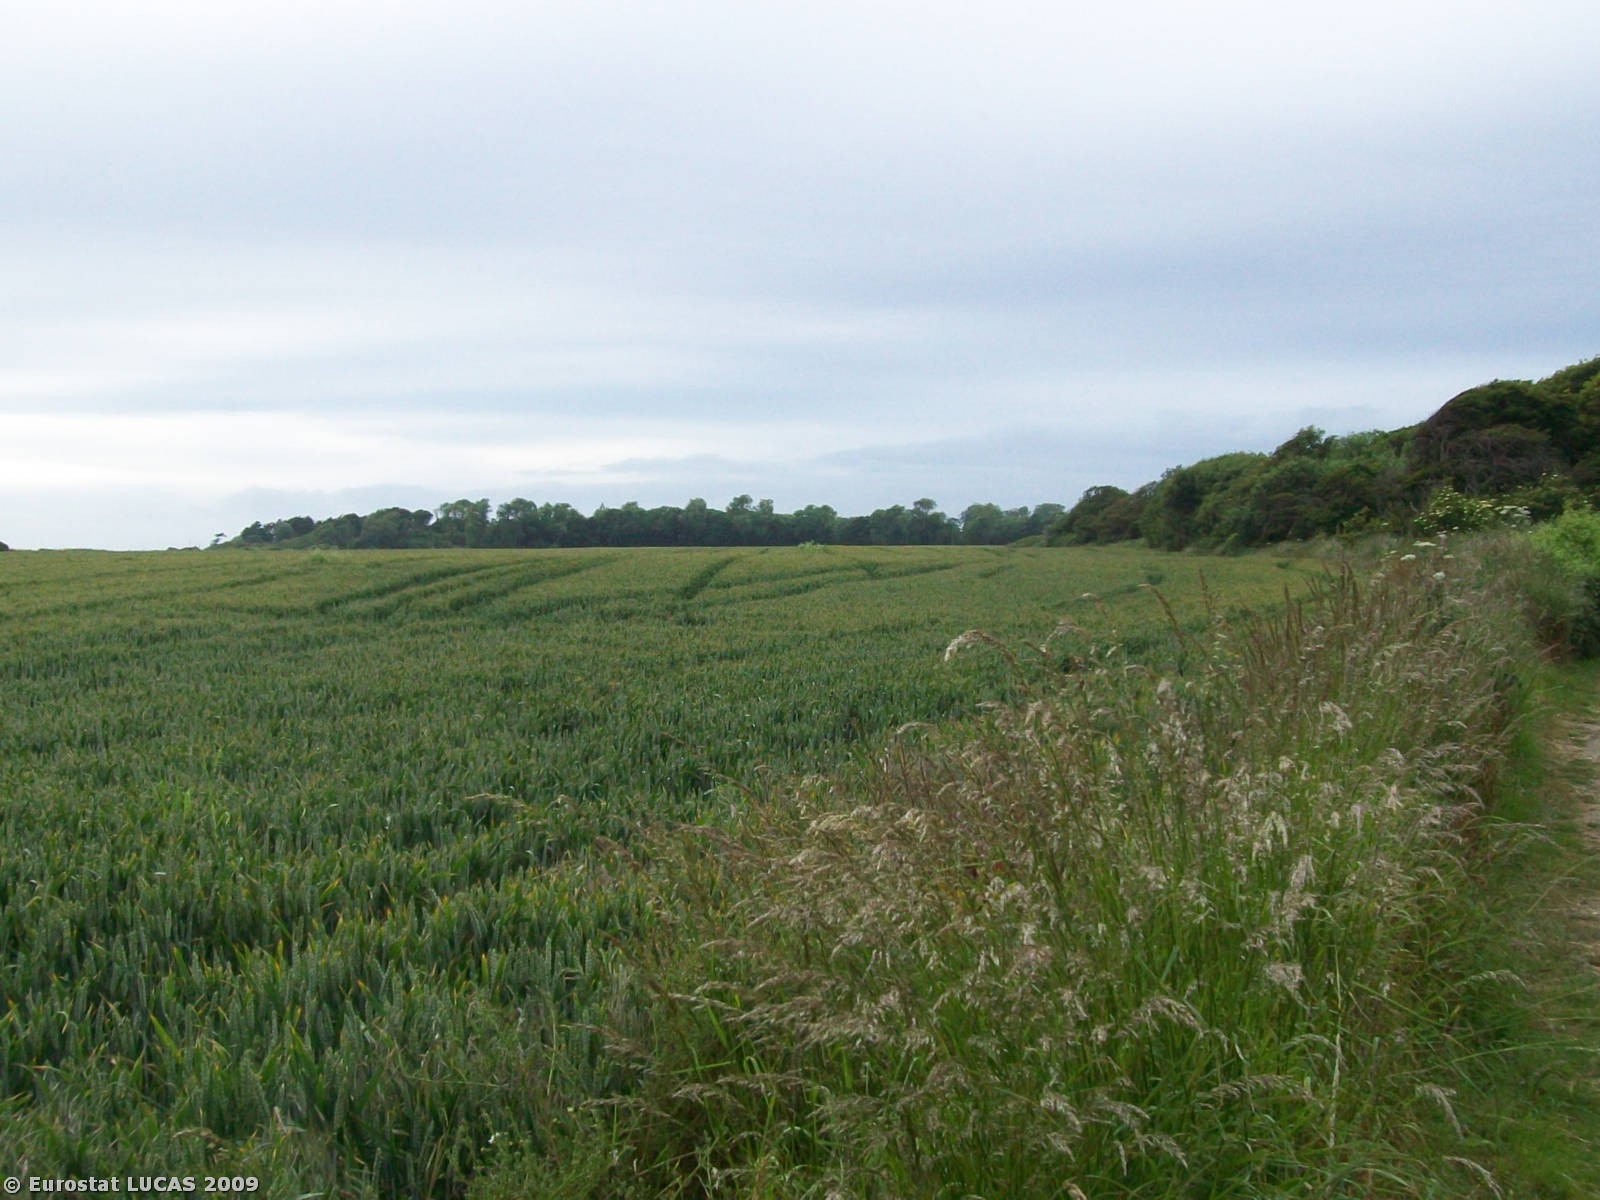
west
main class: Cropland
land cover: Common wheat
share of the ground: > 75 %
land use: Agriculture (excluding fallow land and kitchen gardens)
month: June
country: GB
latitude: 50.7969
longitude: -0.5806
